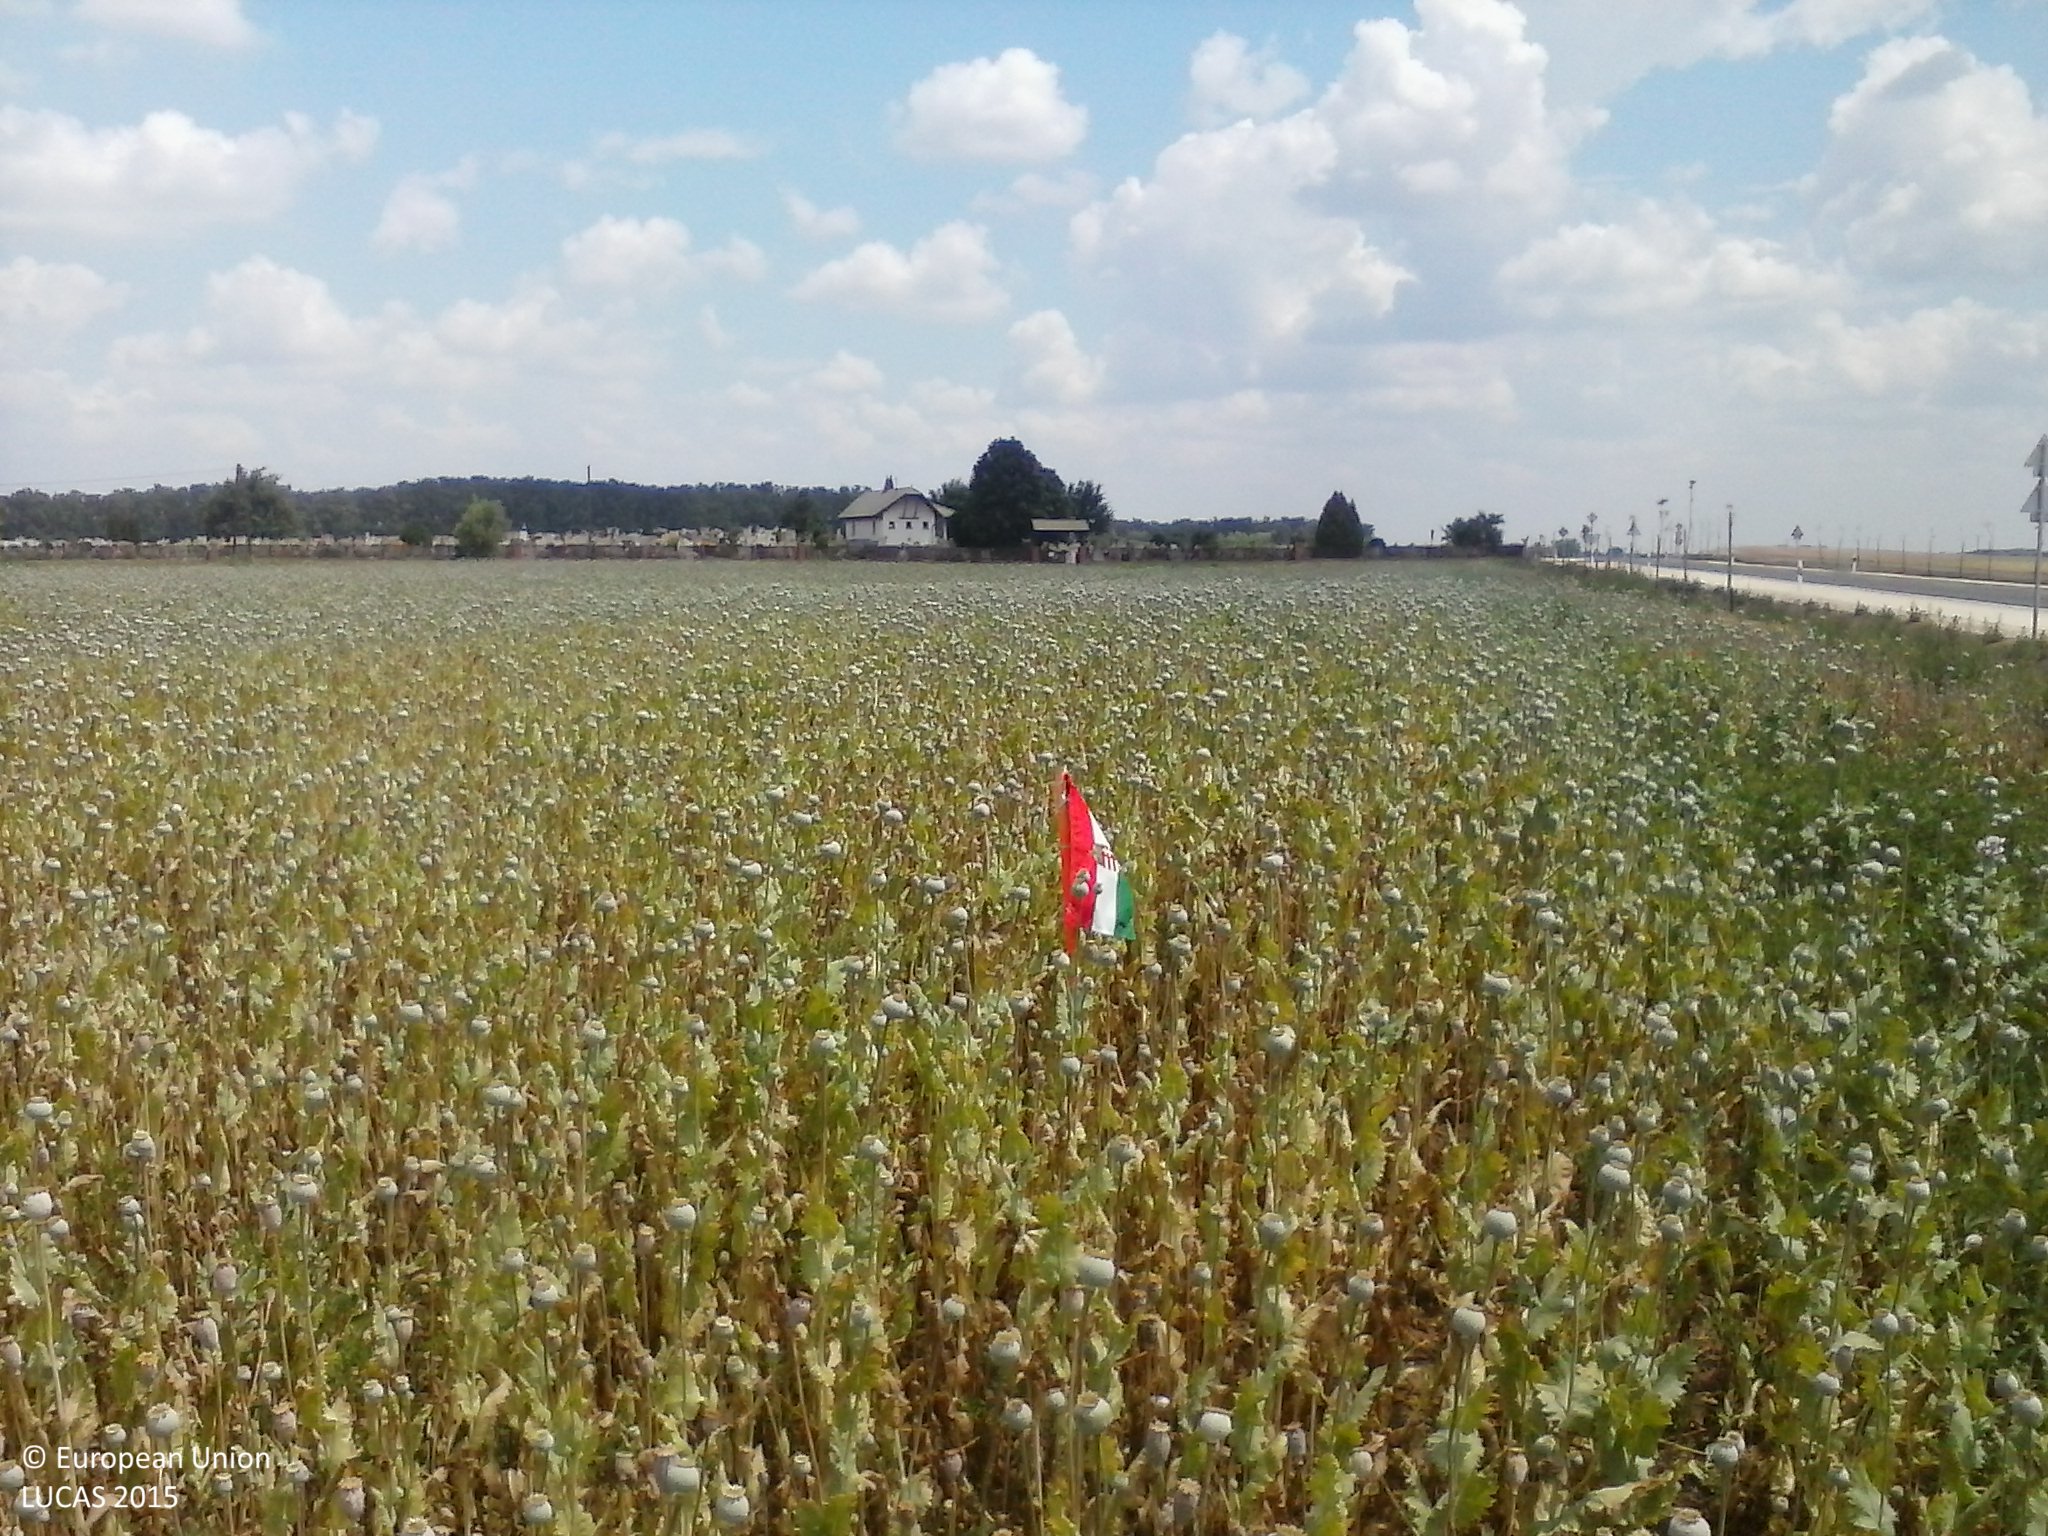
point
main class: Cropland
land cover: Other fibre and oleaginous crops
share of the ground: > 75 %
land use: Agriculture (excluding fallow land and kitchen gardens)
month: June
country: HU
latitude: 46.2718
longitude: 19.5020
